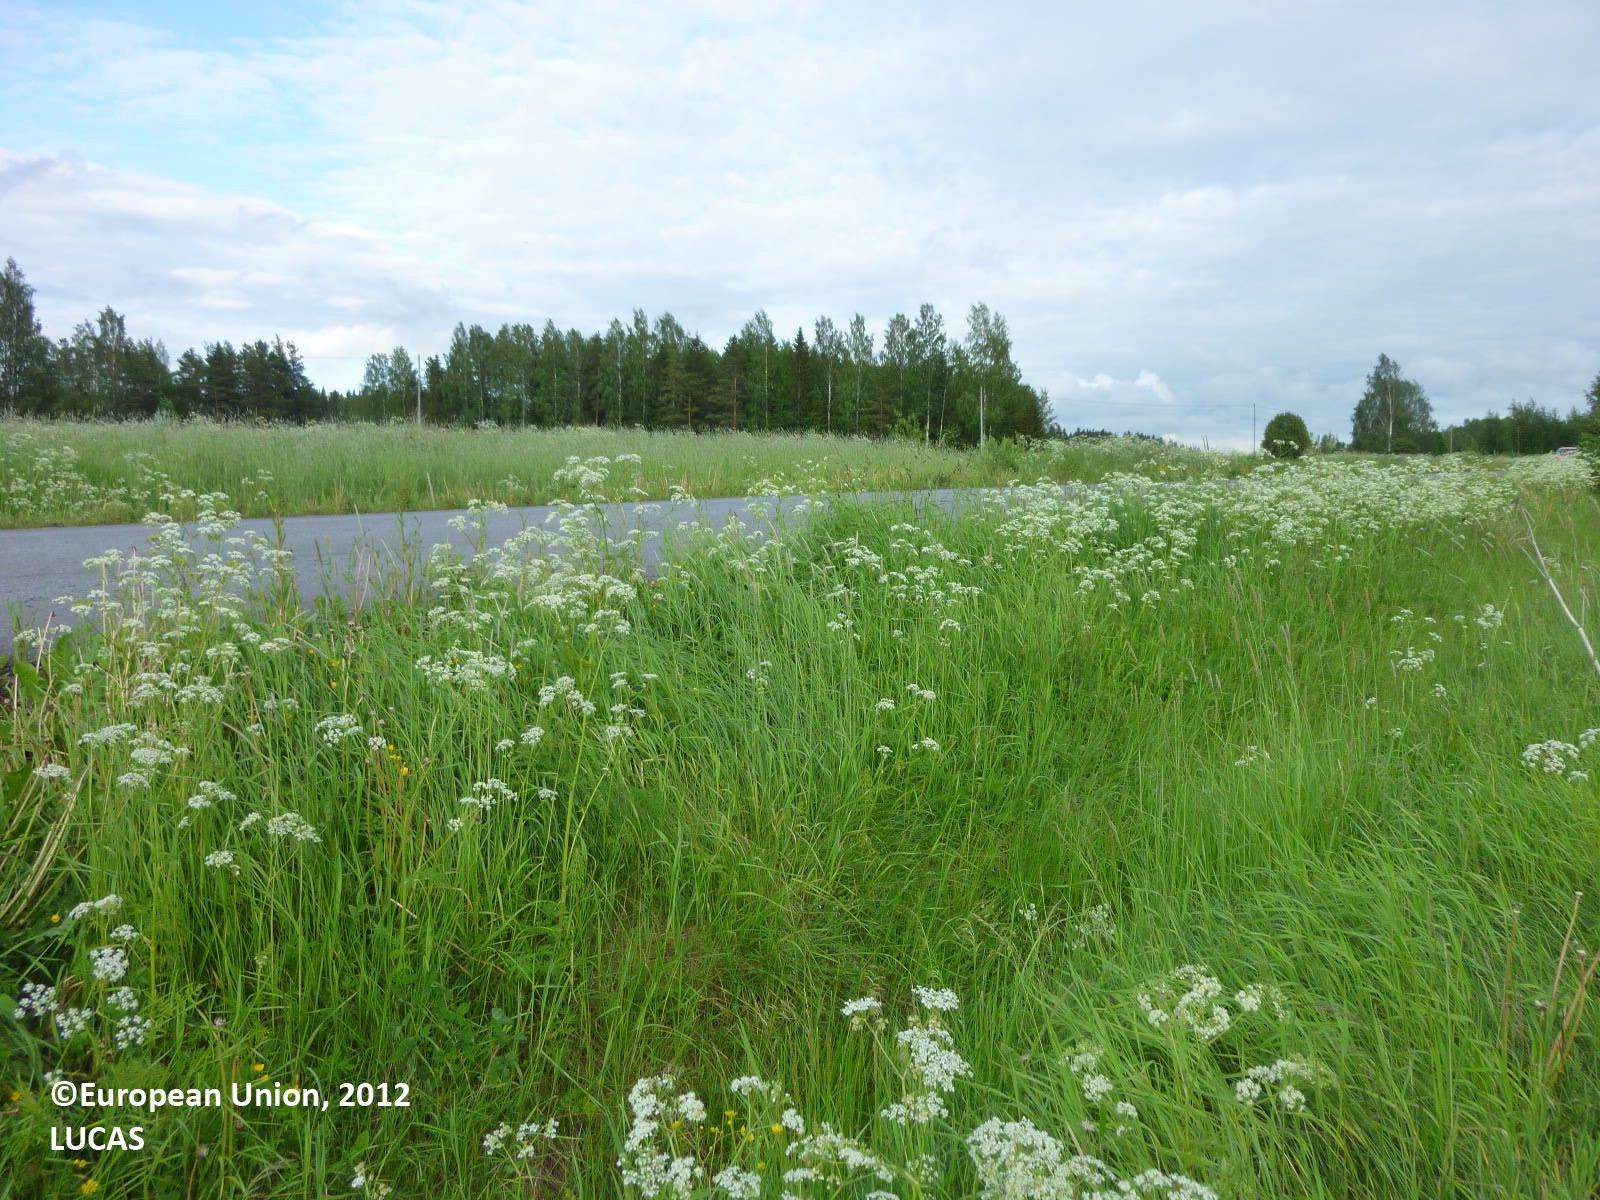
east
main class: Cropland
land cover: Barley
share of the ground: 50 - 75 %
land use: Agriculture (excluding fallow land and kitchen gardens)
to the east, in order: Barley; Grass margins; Ditches and canals; Grass margins; Paved roads, cycling and walking lanes; Grassland without tree/shrub cover; Oats; Electric lines; Oats; Grass margins; Ditches and canals; Grass margins; Paved roads, cycling and walking lanes; Grass margins; Spruce dominated mixed woodland; Broadleaved woodland
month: June
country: FI
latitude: 61.6322
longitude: 22.4956
